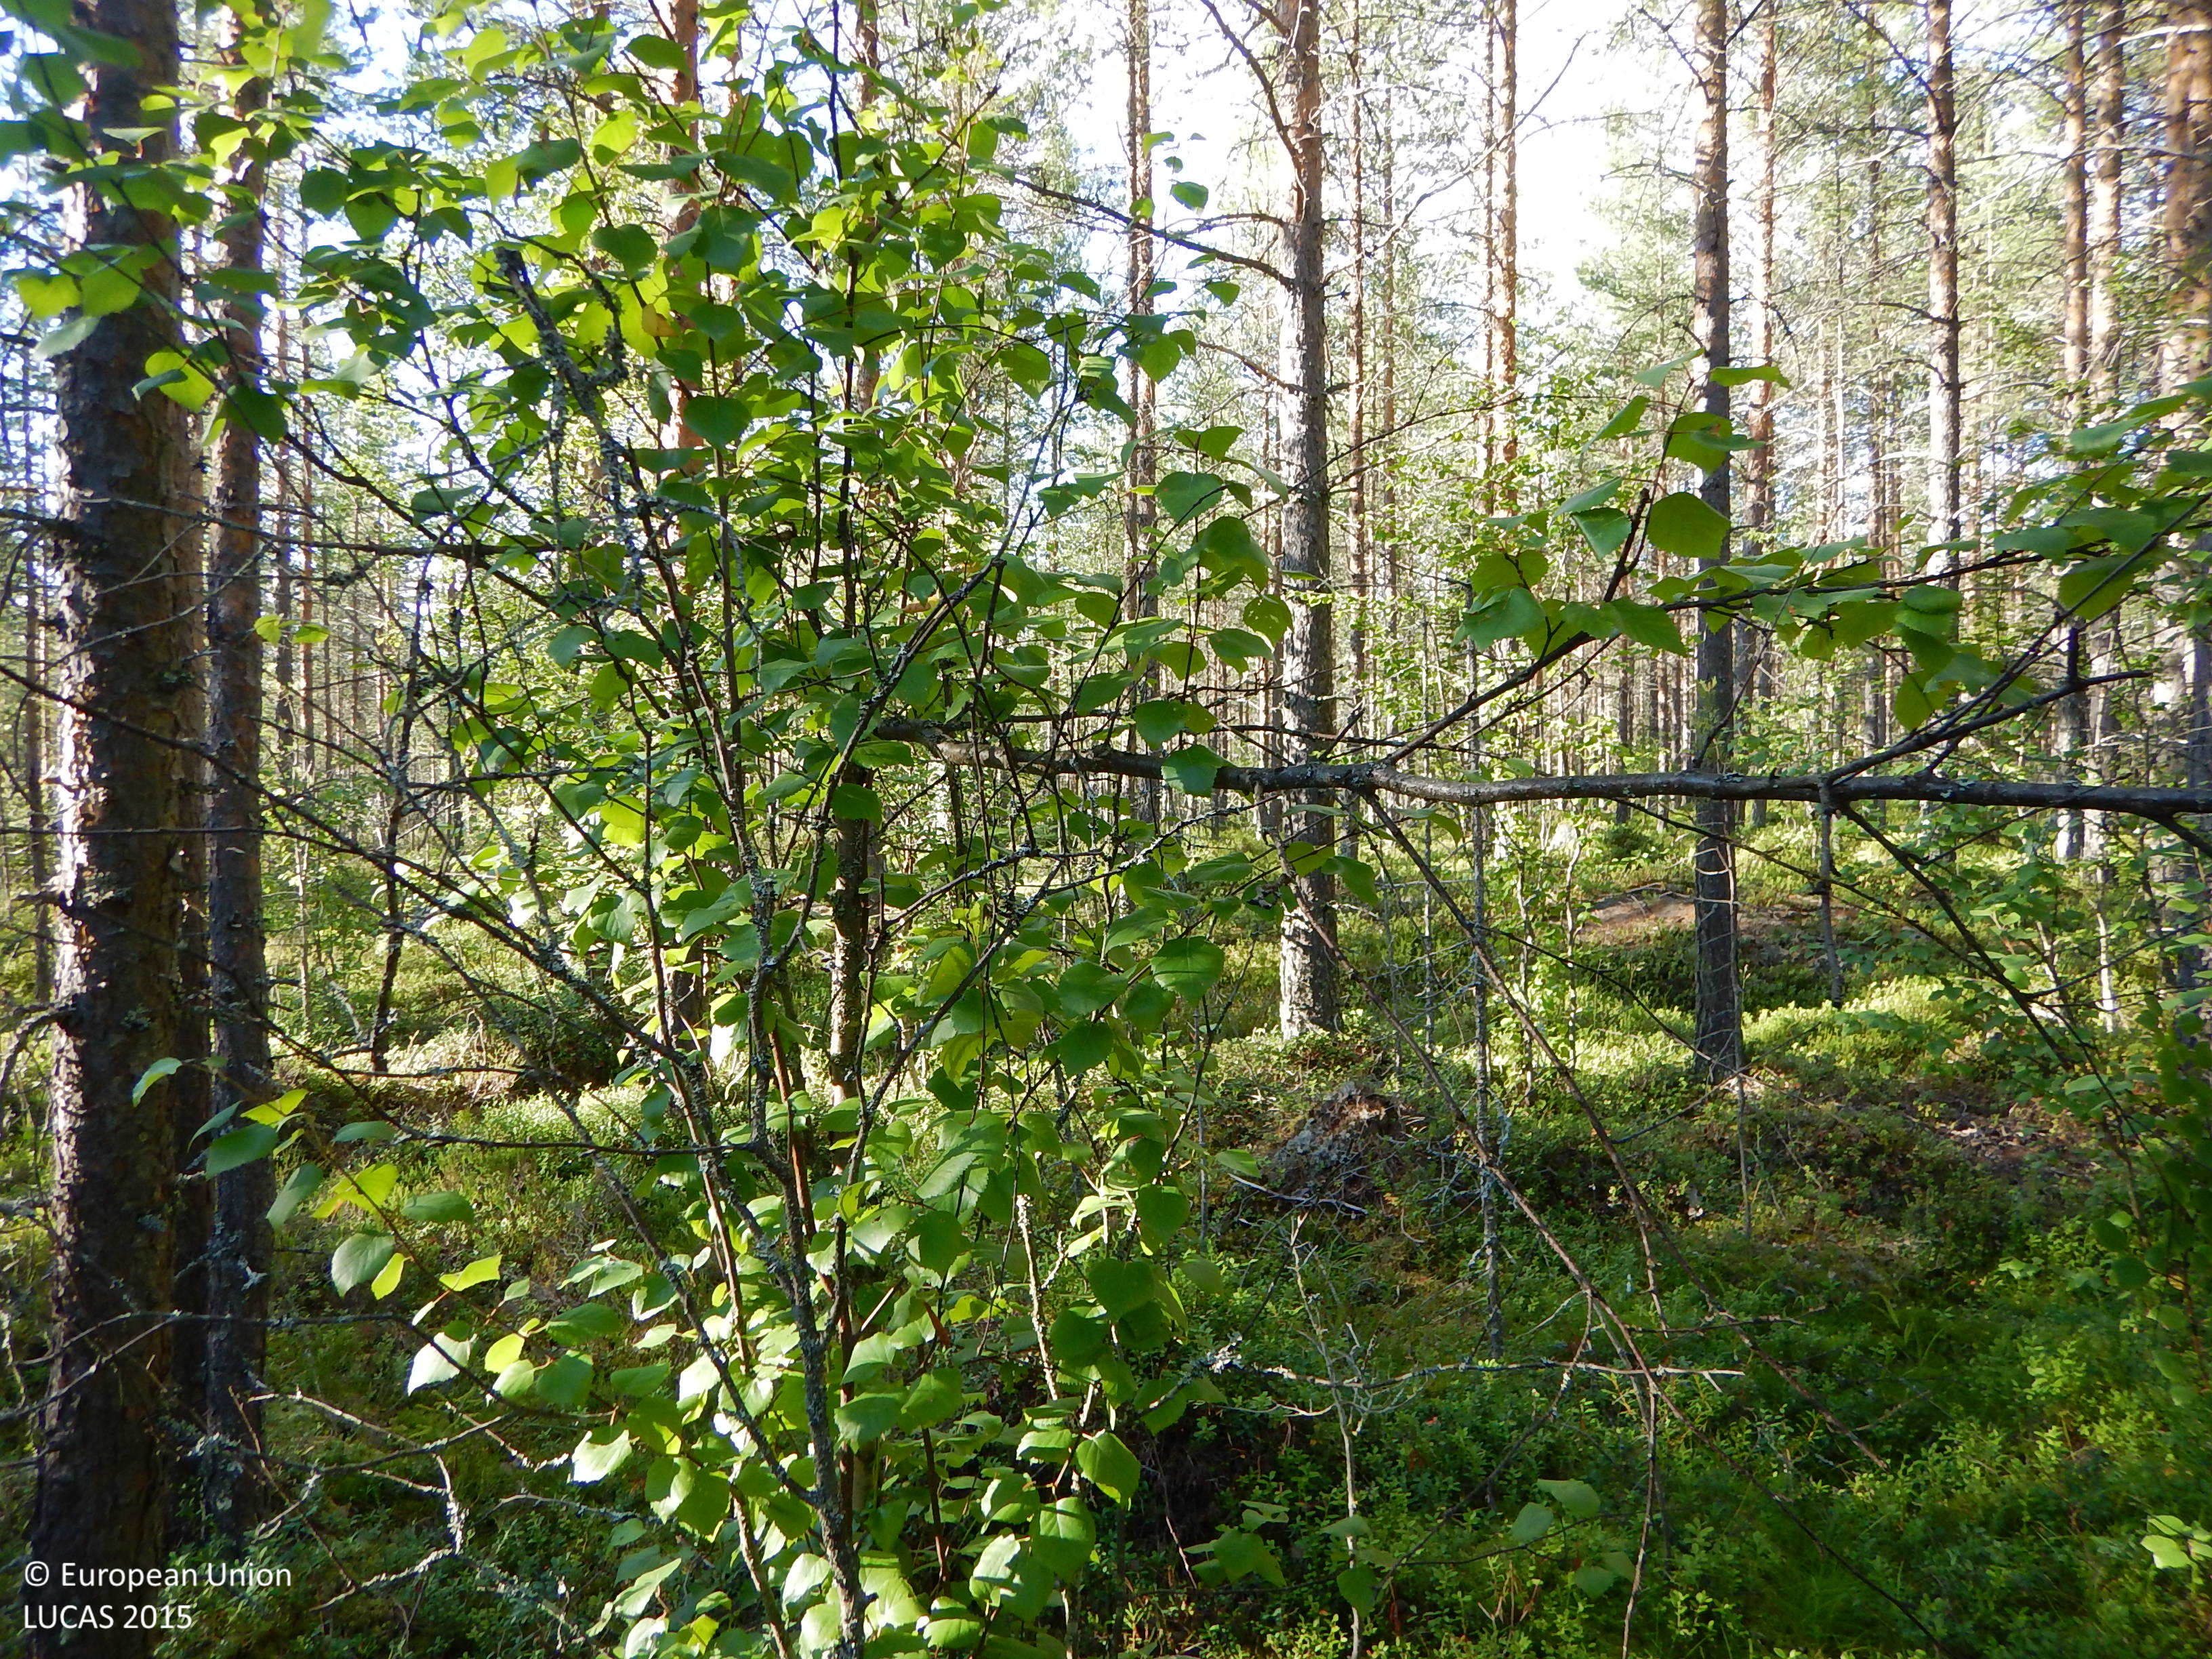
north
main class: Woodland
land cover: Pine dominated coniferous woodland
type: boreal forest
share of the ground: 50 - 75 %
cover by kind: coniferous forest trees 50 %, herbaceous plants 15 %, lichens and mosses 15 %, broadleaved forest trees 10 %, shrubs 10 %
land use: Forestry
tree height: > 5 m
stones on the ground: < 10 %
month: July
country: SE
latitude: 64.7865
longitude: 20.9388
